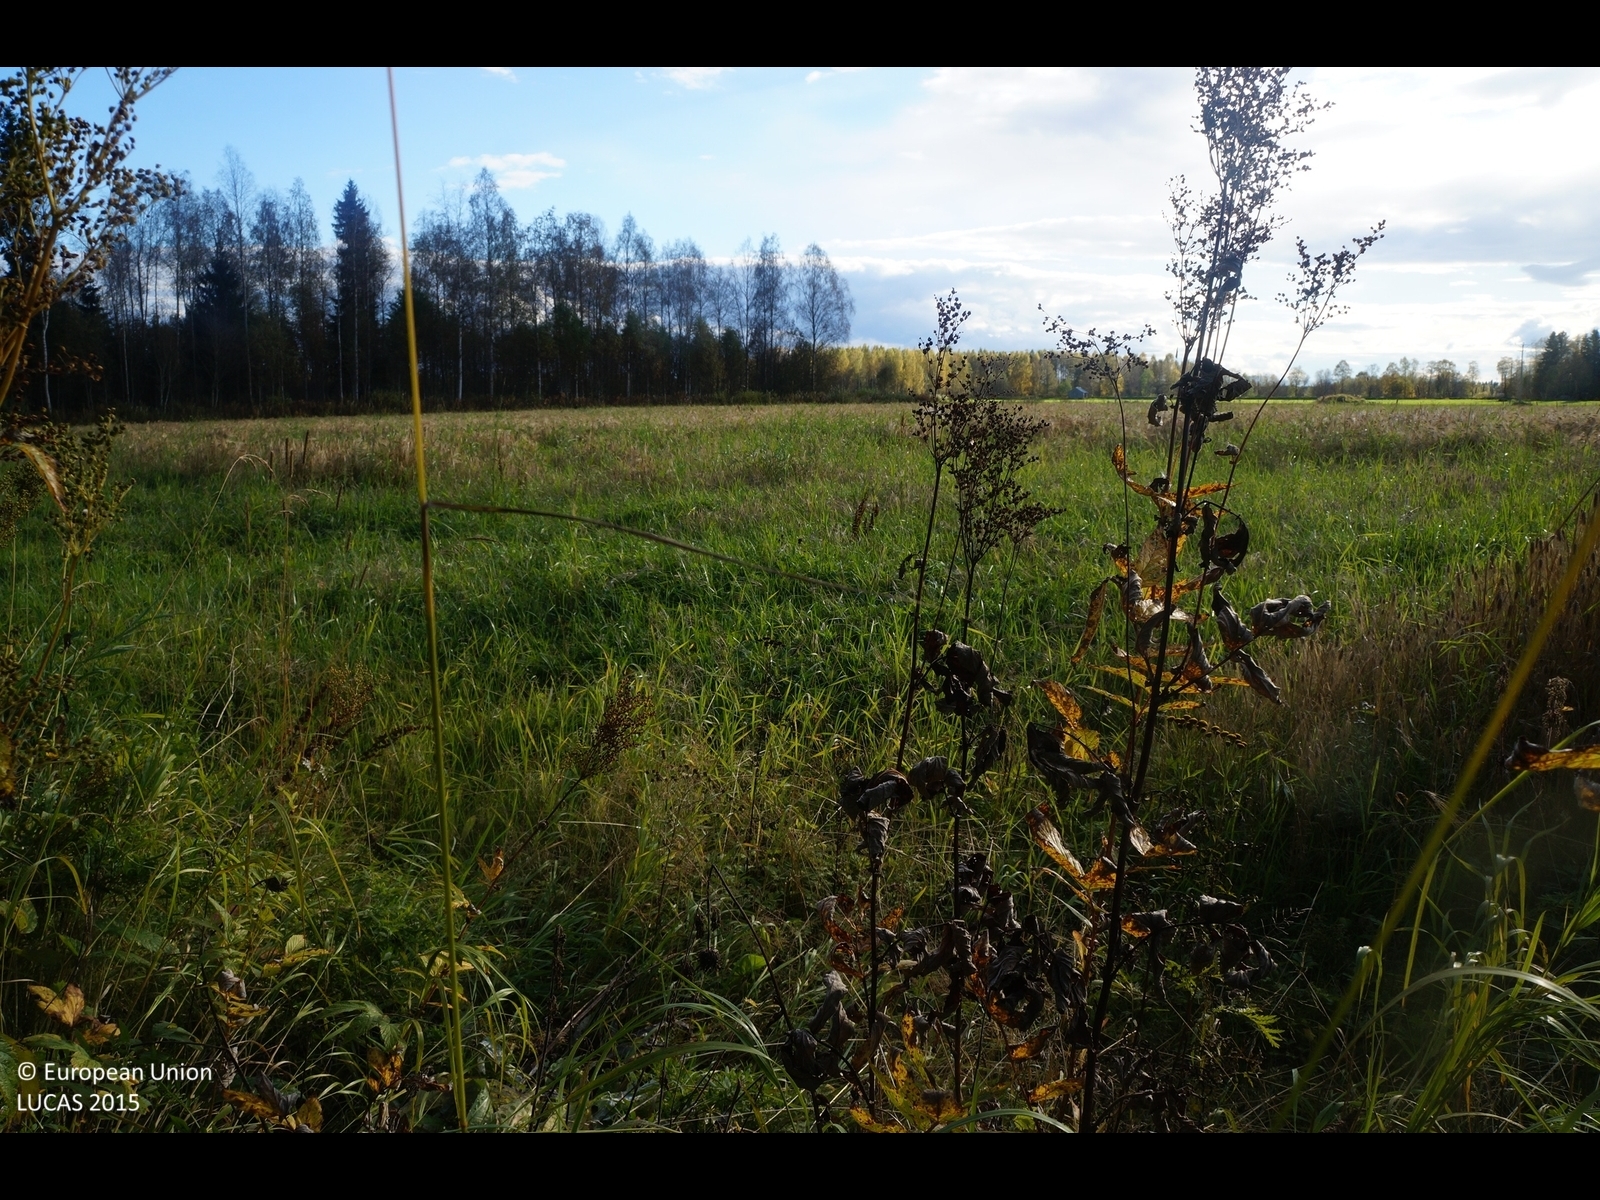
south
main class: Woodland
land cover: Spruce dominated mixed woodland
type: boreal forest
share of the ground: 50 - 75 %
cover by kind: coniferous forest trees 50 %, broadleaved forest trees 20 %, shrubs 20 %, lichens and mosses 10 %
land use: Forestry
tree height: > 5 m
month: September
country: FI
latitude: 64.2721
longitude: 24.5881
